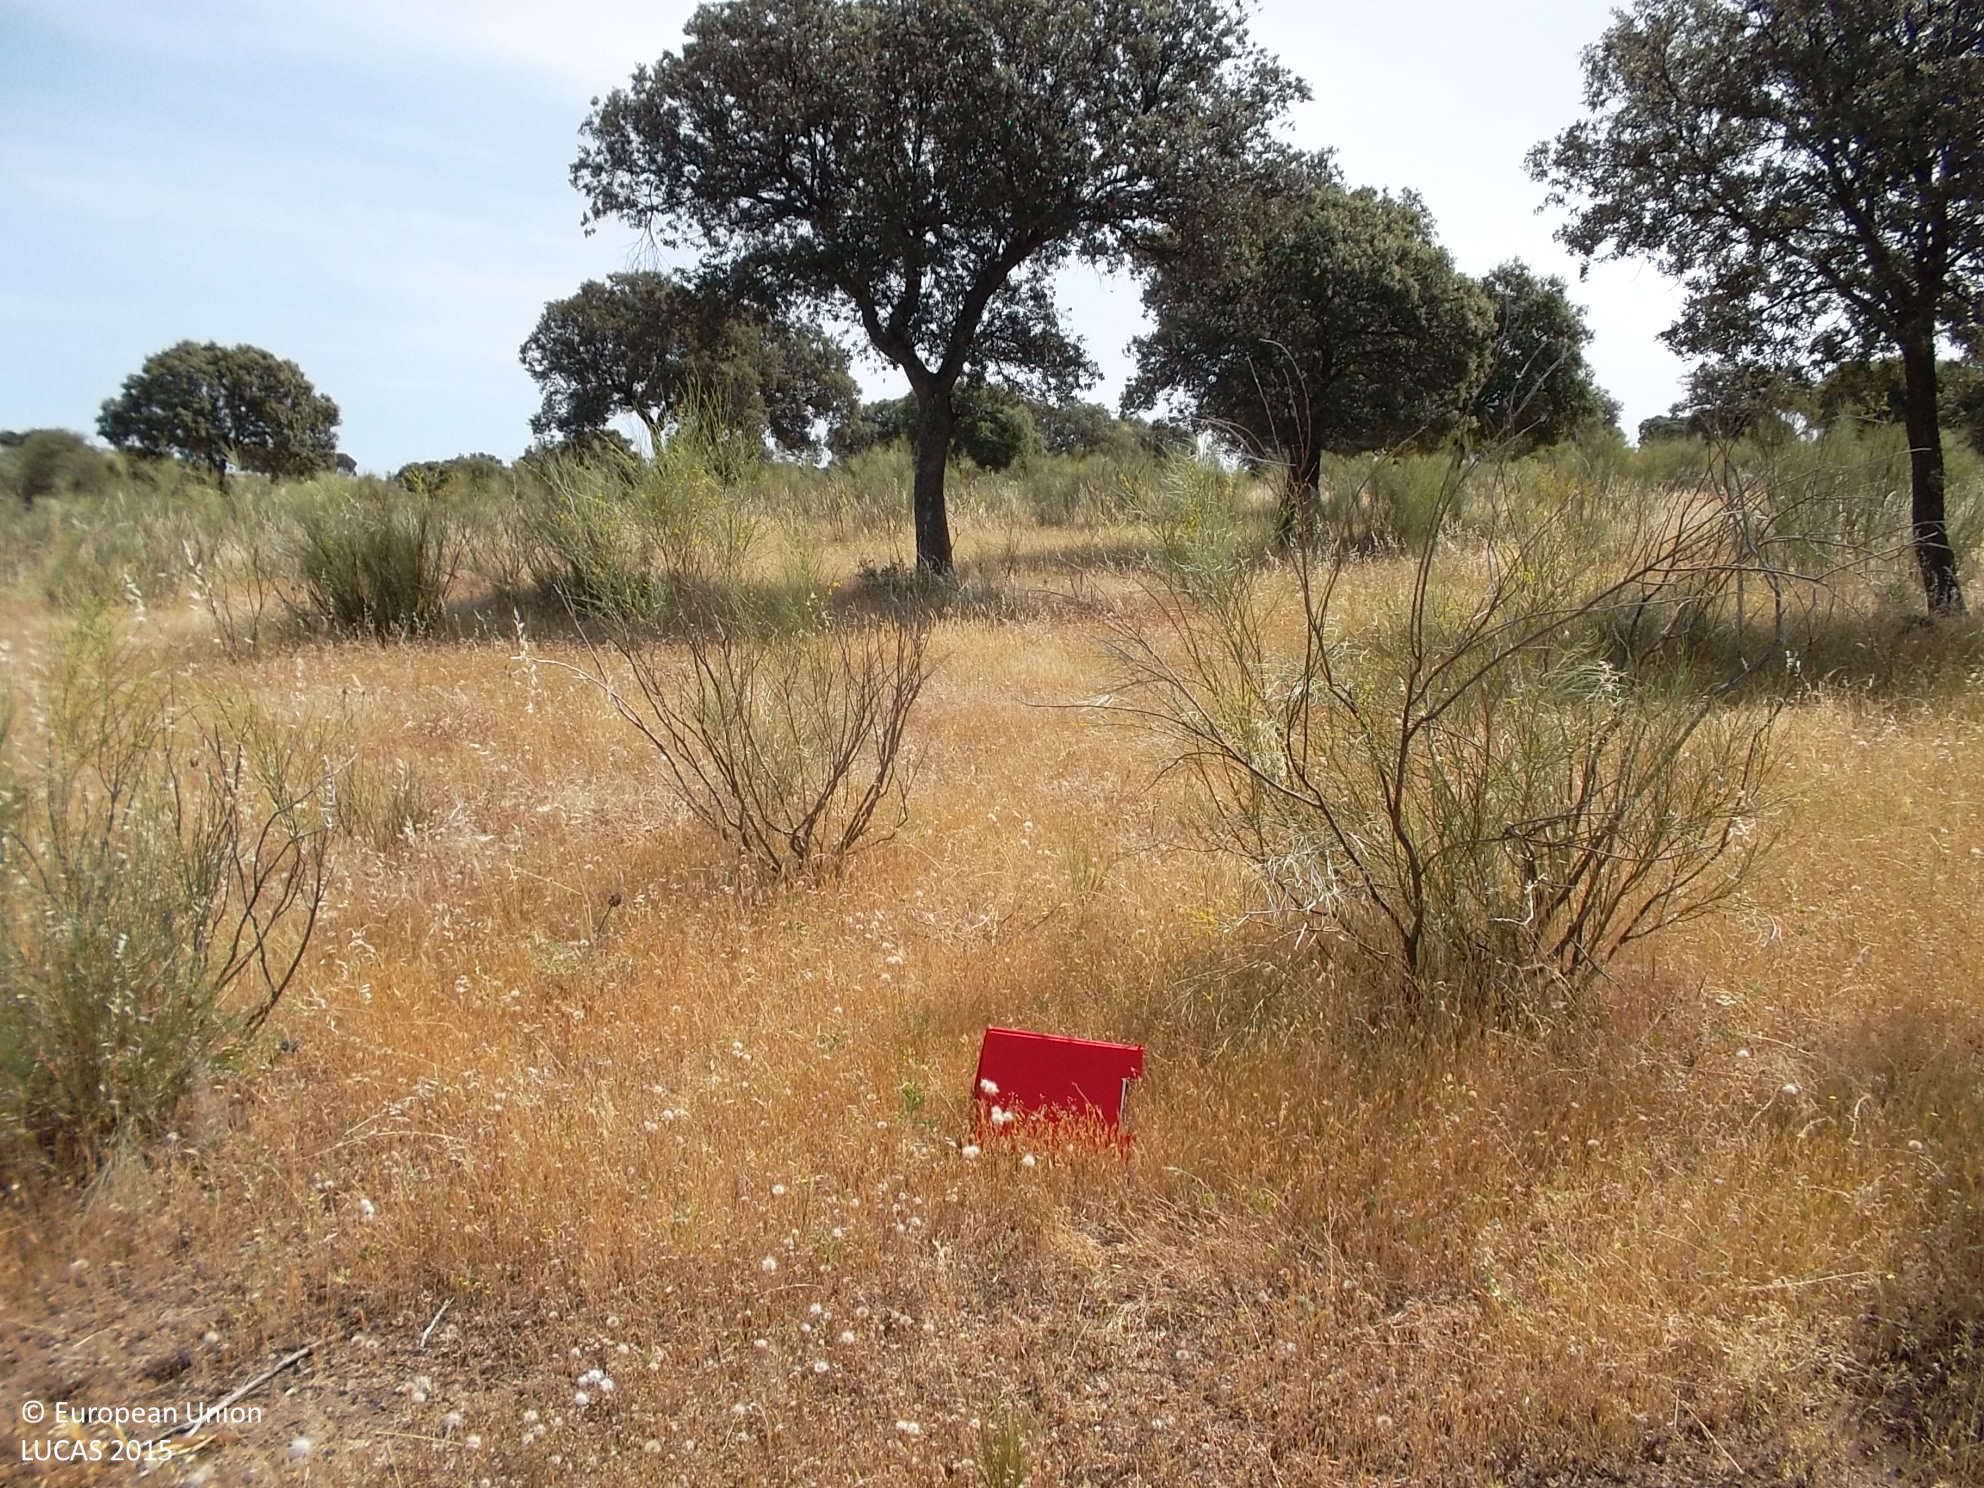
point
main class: Woodland
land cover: Broadleaved woodland
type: broadleaved evergreen forest
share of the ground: 10 - 25 %
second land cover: Shrubland without tree cover
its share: 50 - 75 %
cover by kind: herbaceous plants 55 %, shrubs 30 %, broadleaved forest trees 15 %
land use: Forestry
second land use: Agriculture (excluding fallow land and kitchen gardens)
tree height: > 5 m
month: May
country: ES
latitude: 38.6539
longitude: -4.7229
